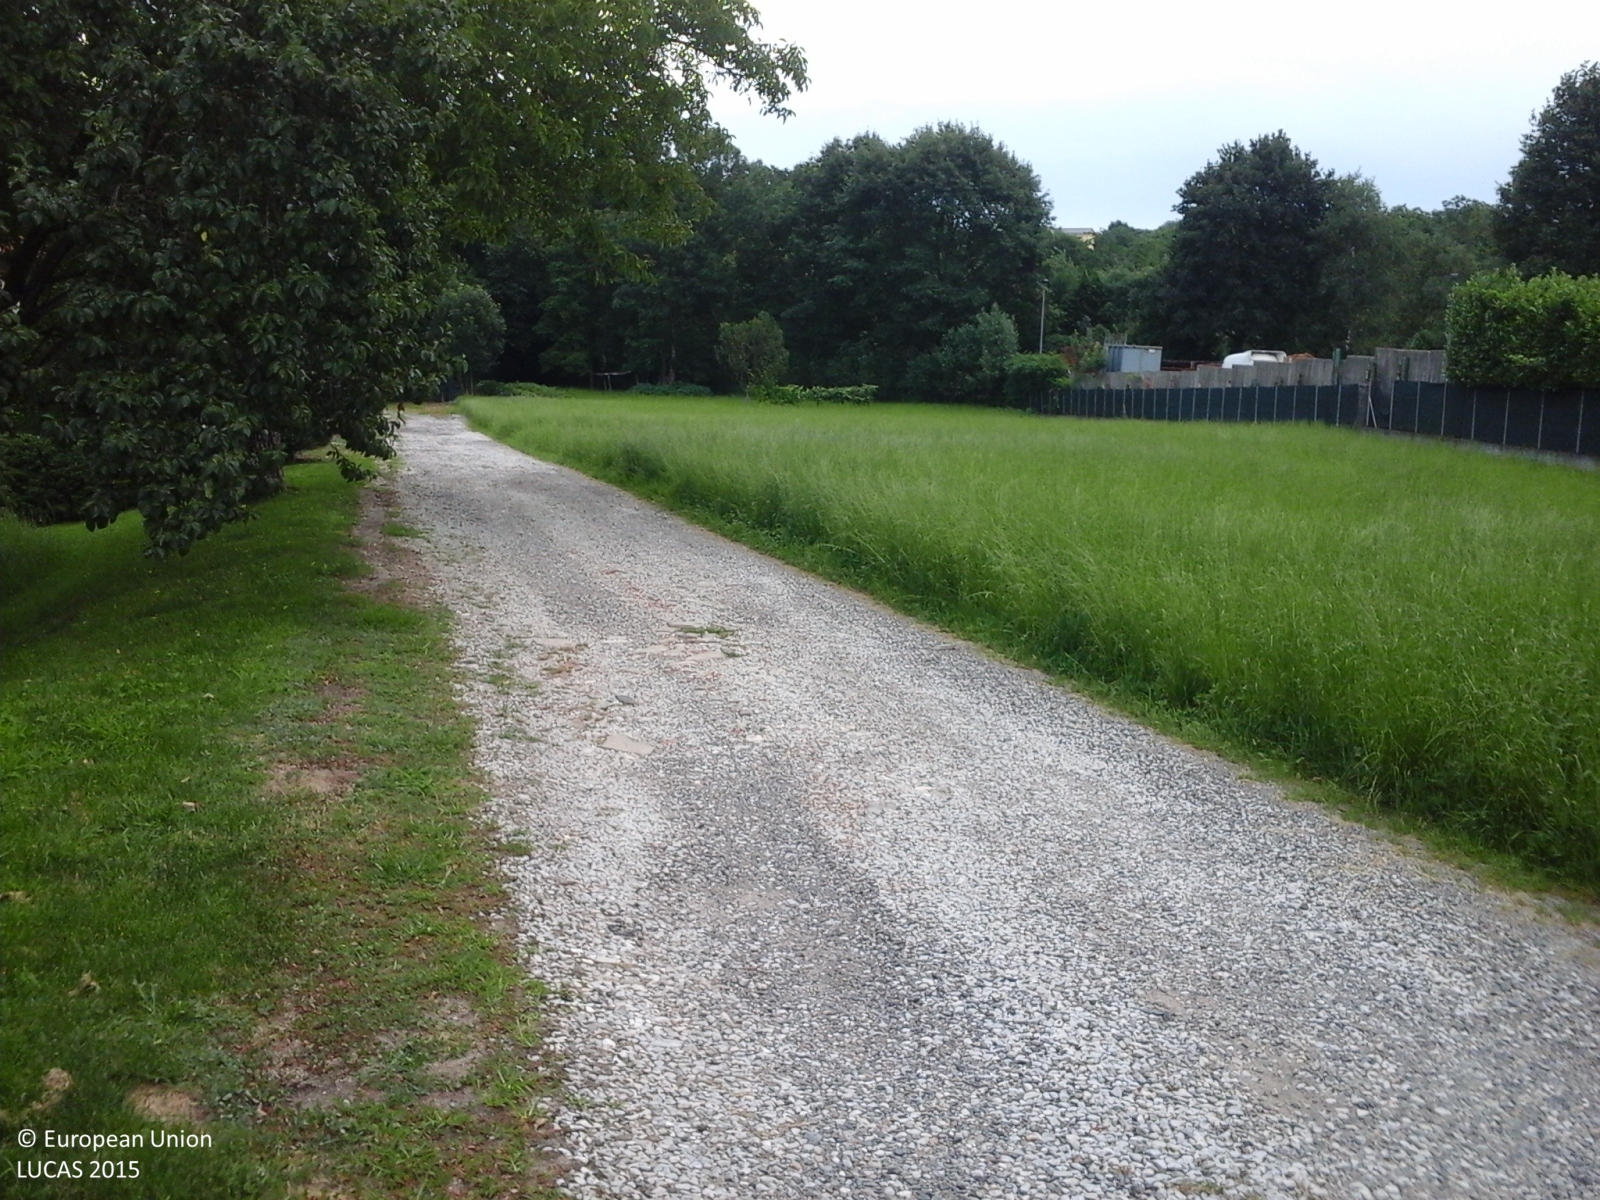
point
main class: Grassland
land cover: Grassland without tree/shrub cover
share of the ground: > 75 %
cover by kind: herbaceous plants 100 %
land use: Agriculture (excluding fallow land and kitchen gardens)
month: June
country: IT
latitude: 45.8565
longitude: 8.6754
